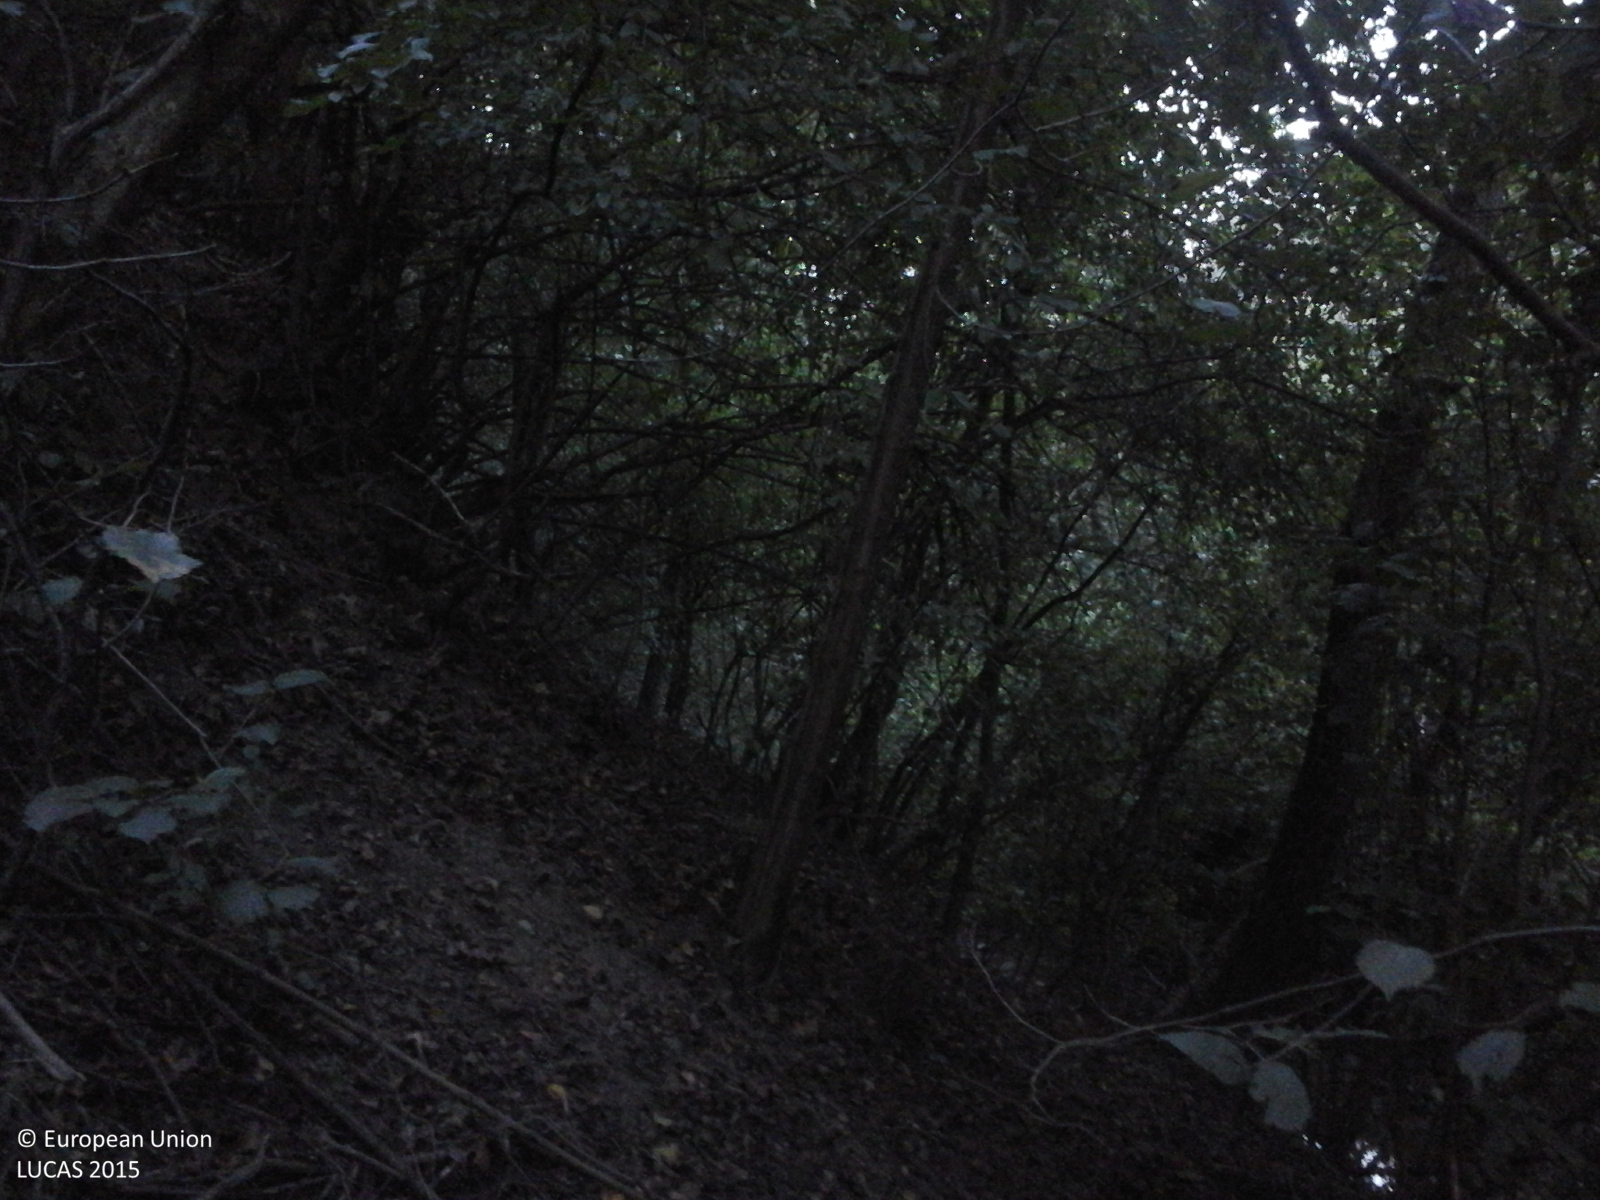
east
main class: Woodland
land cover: Broadleaved woodland
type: beech forest
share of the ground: > 75 %
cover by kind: broadleaved forest trees 100 %
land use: Forestry
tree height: > 5 m
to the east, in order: Broadleaved woodland; Rivers and streams; Broadleaved woodland
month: September
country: RO
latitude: 47.2127
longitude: 23.4463
